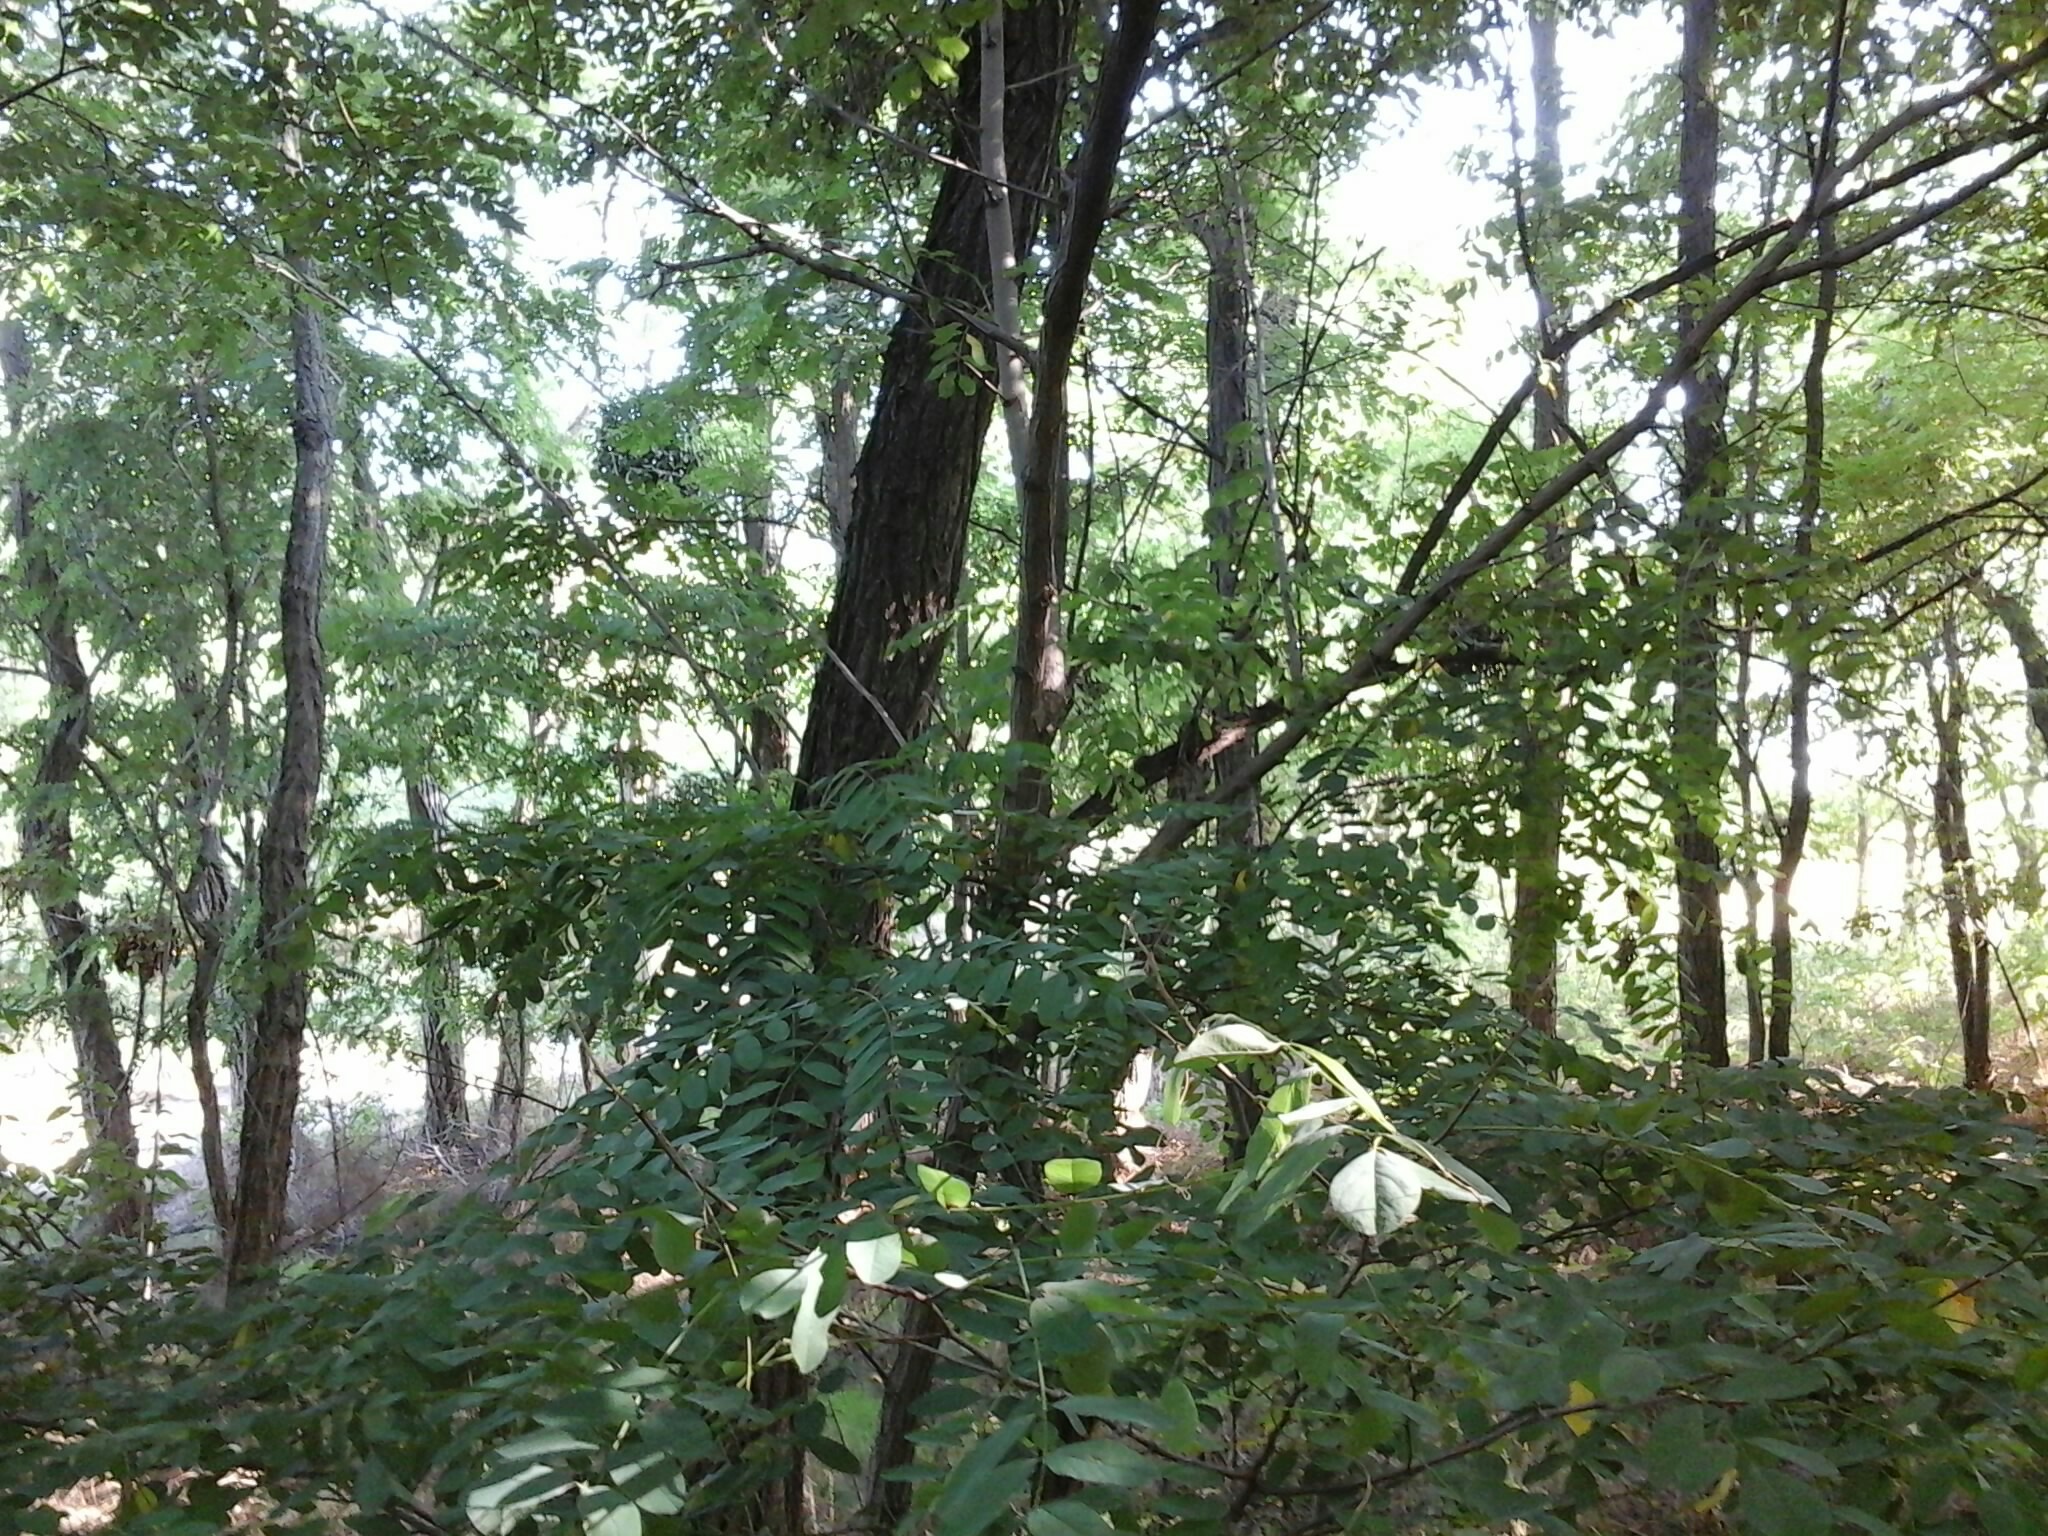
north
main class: Woodland
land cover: Broadleaved woodland
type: exotic forest
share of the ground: > 75 %
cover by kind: broadleaved forest trees 95 %, herbaceous plants 5 %
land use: Forestry
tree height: > 5 m
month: August
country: HU
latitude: 47.4853
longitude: 17.9334
